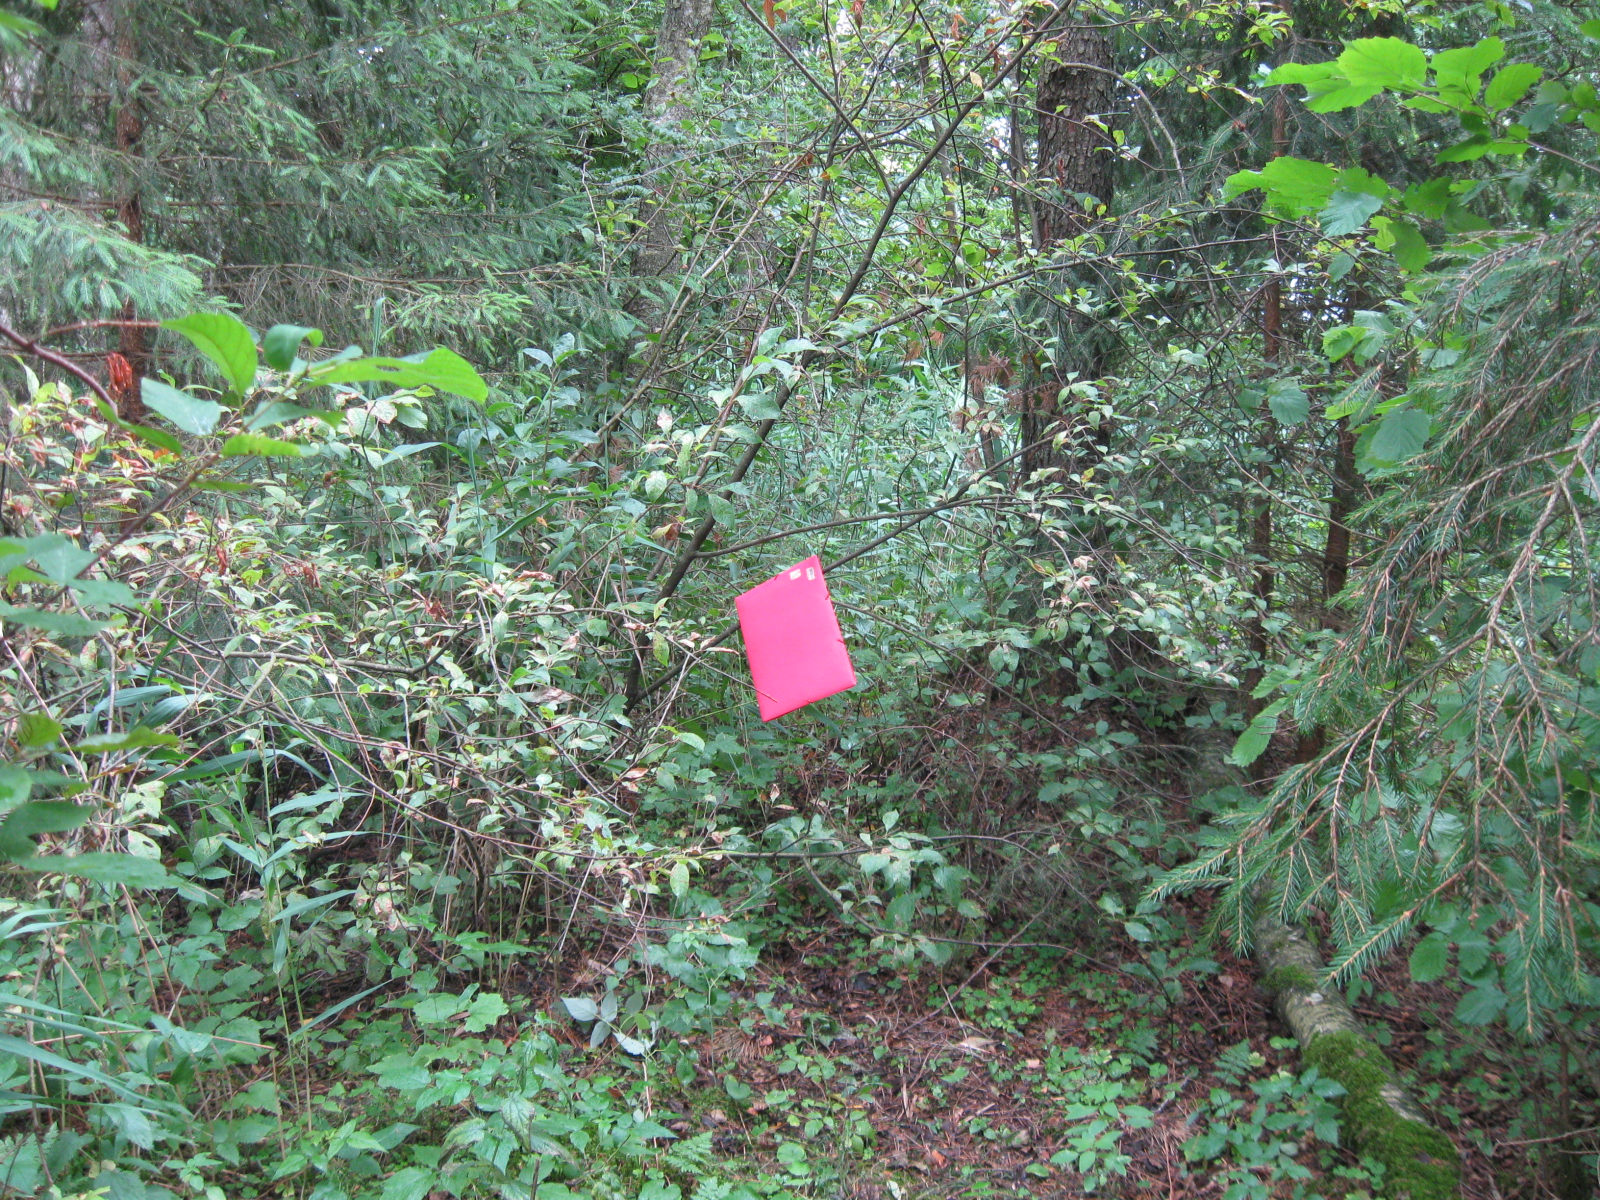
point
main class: Woodland
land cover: Other mixed woodland
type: mire and swamp forests
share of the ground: > 75 %
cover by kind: broadleaved forest trees 50 %, coniferous forest trees 35 %, shrubs 10 %, herbaceous plants 5 %
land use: Forestry
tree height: > 5 m
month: July
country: LT
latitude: 54.2969
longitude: 24.3435
